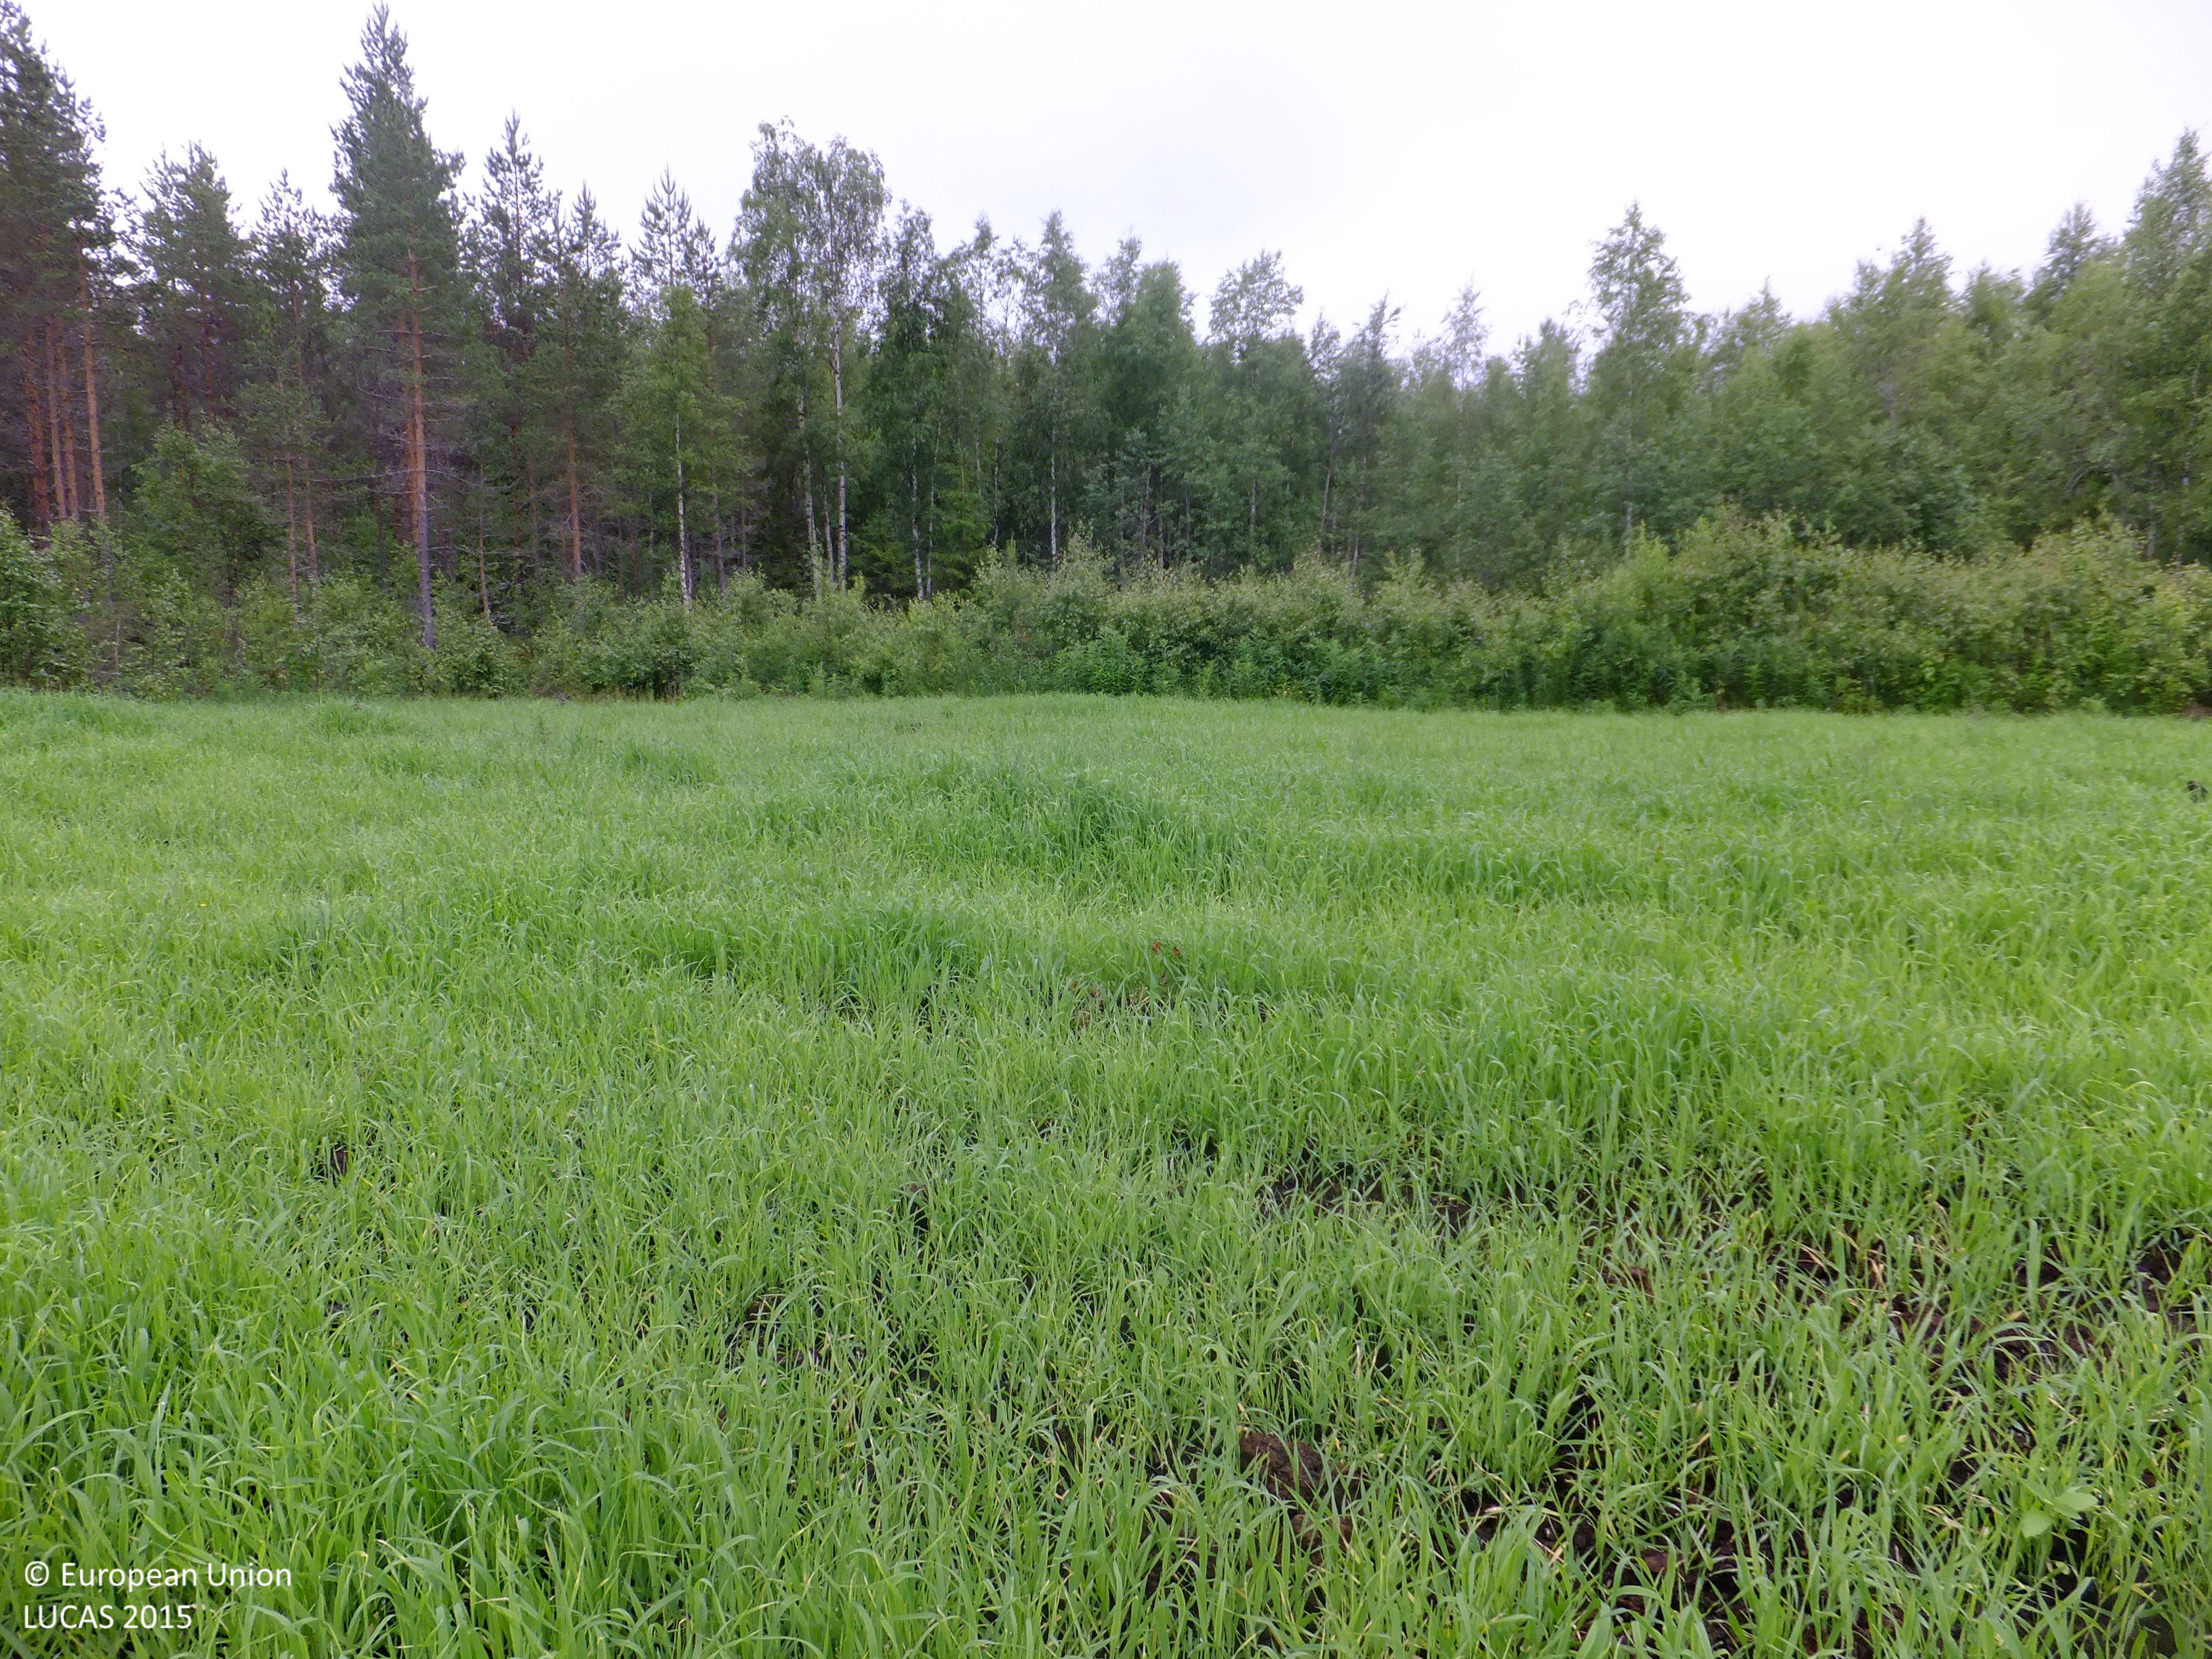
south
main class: Cropland
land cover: Barley
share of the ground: 50 - 75 %
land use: Agriculture (excluding fallow land and kitchen gardens)
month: July
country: FI
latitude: 63.1577
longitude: 24.6773
